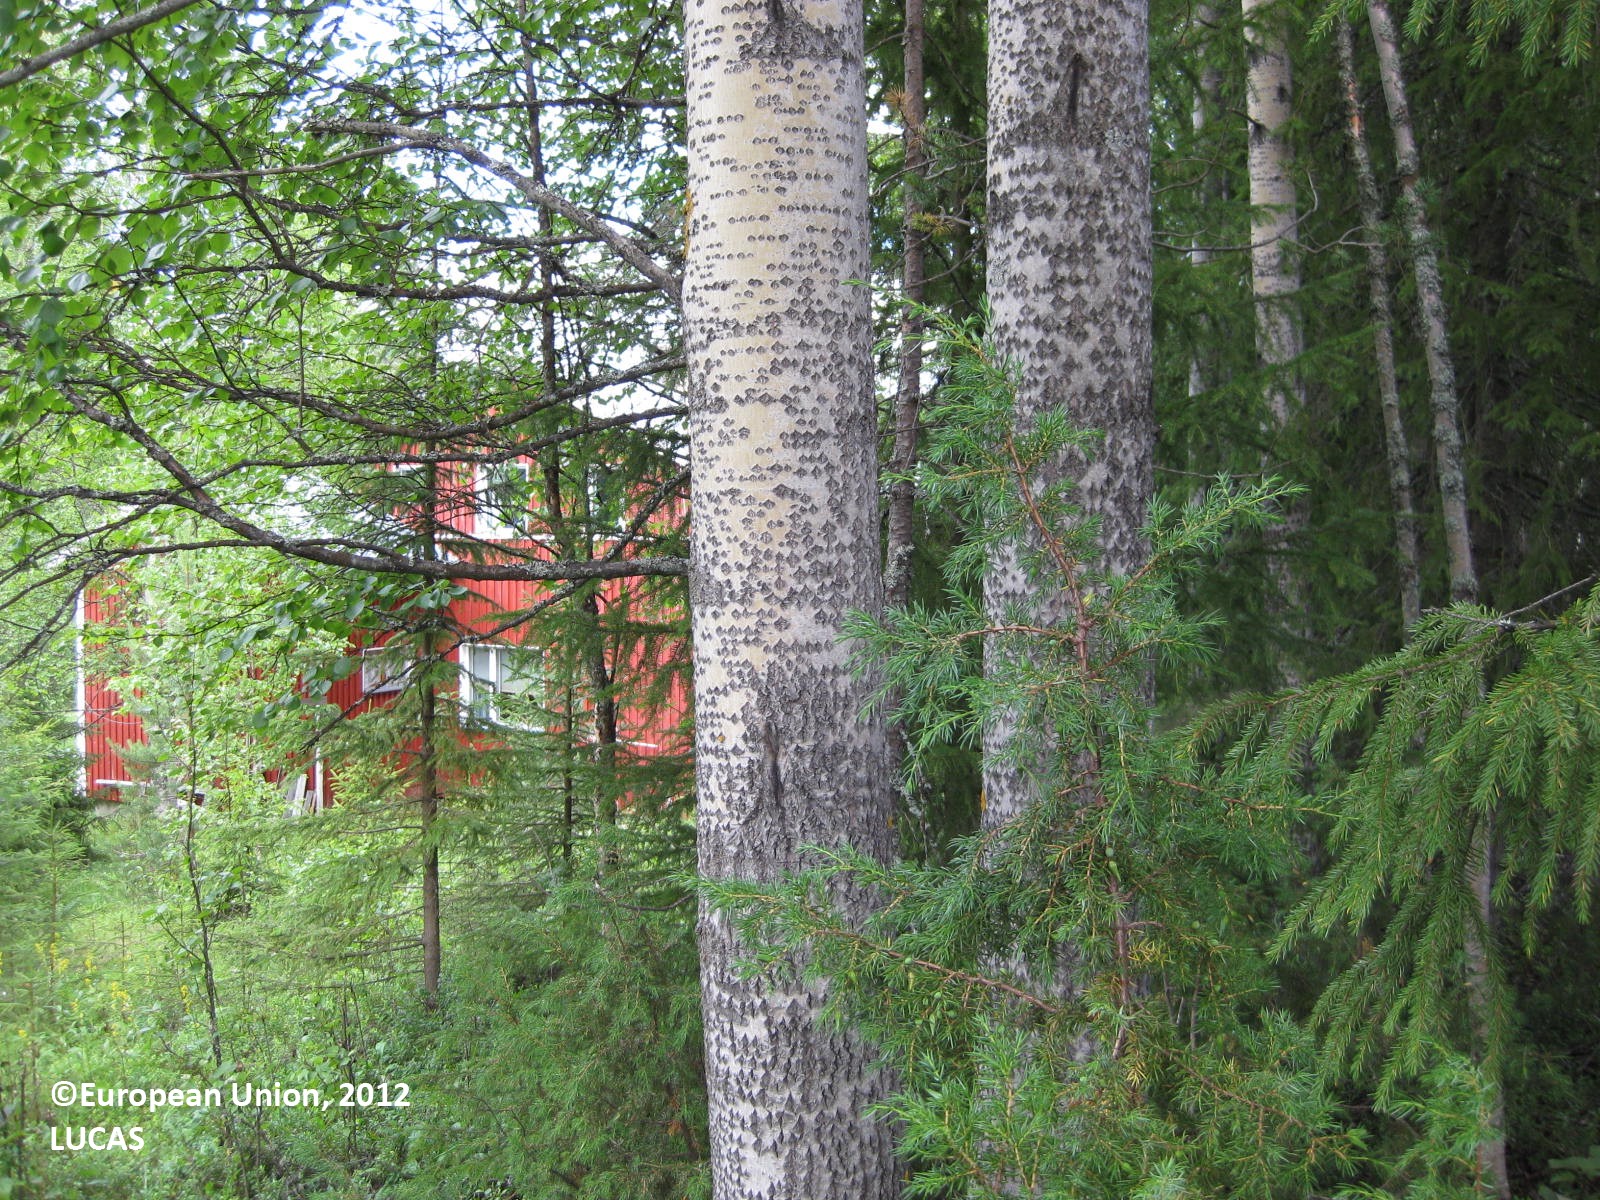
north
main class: Woodland
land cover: Spruce dominated mixed woodland
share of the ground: > 75 %
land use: Residential
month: July
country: FI
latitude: 65.7034
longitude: 28.5203
